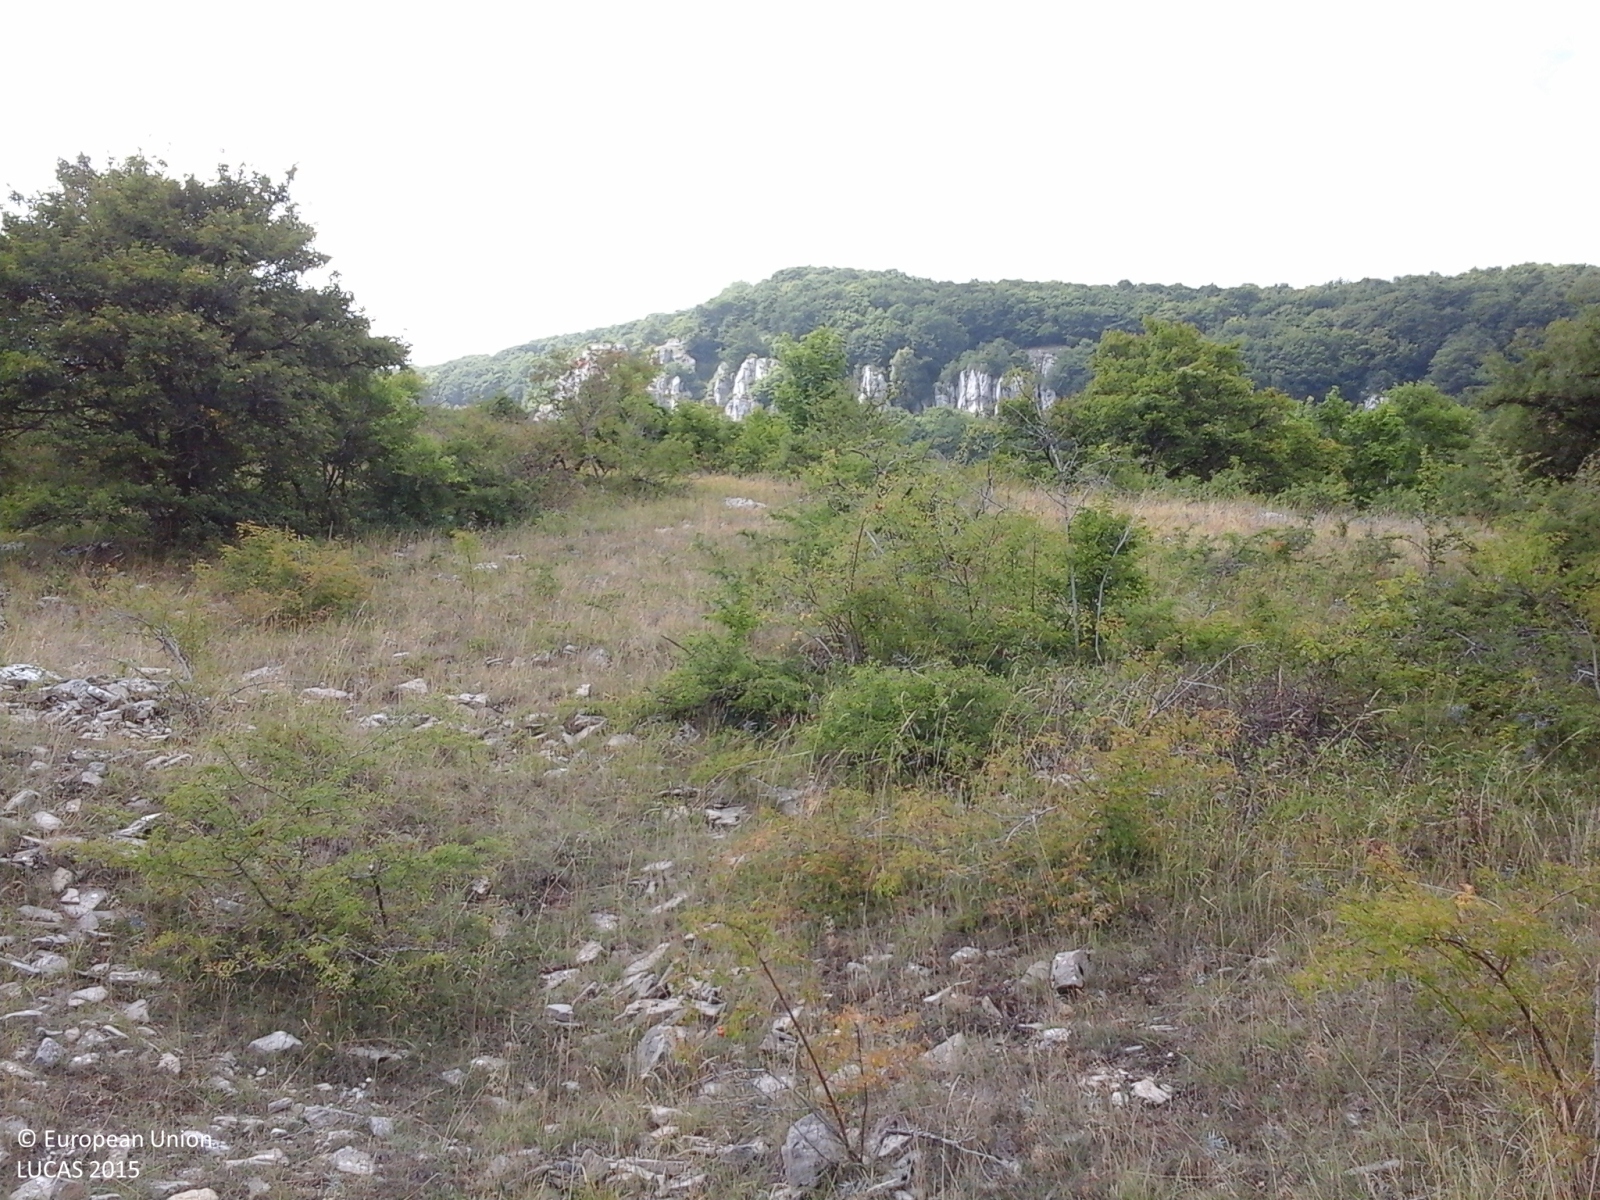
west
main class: Shrubland
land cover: Shrubland with sparse tree cover
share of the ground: > 75 %
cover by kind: herbaceous plants 50 %, shrubs 45 %, broadleaved forest trees 5 %
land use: Semi-natural and natural areas not in use
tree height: < 5 m
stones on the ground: 10 - 25 %
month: August
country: IT
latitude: 41.8037
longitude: 14.2822
